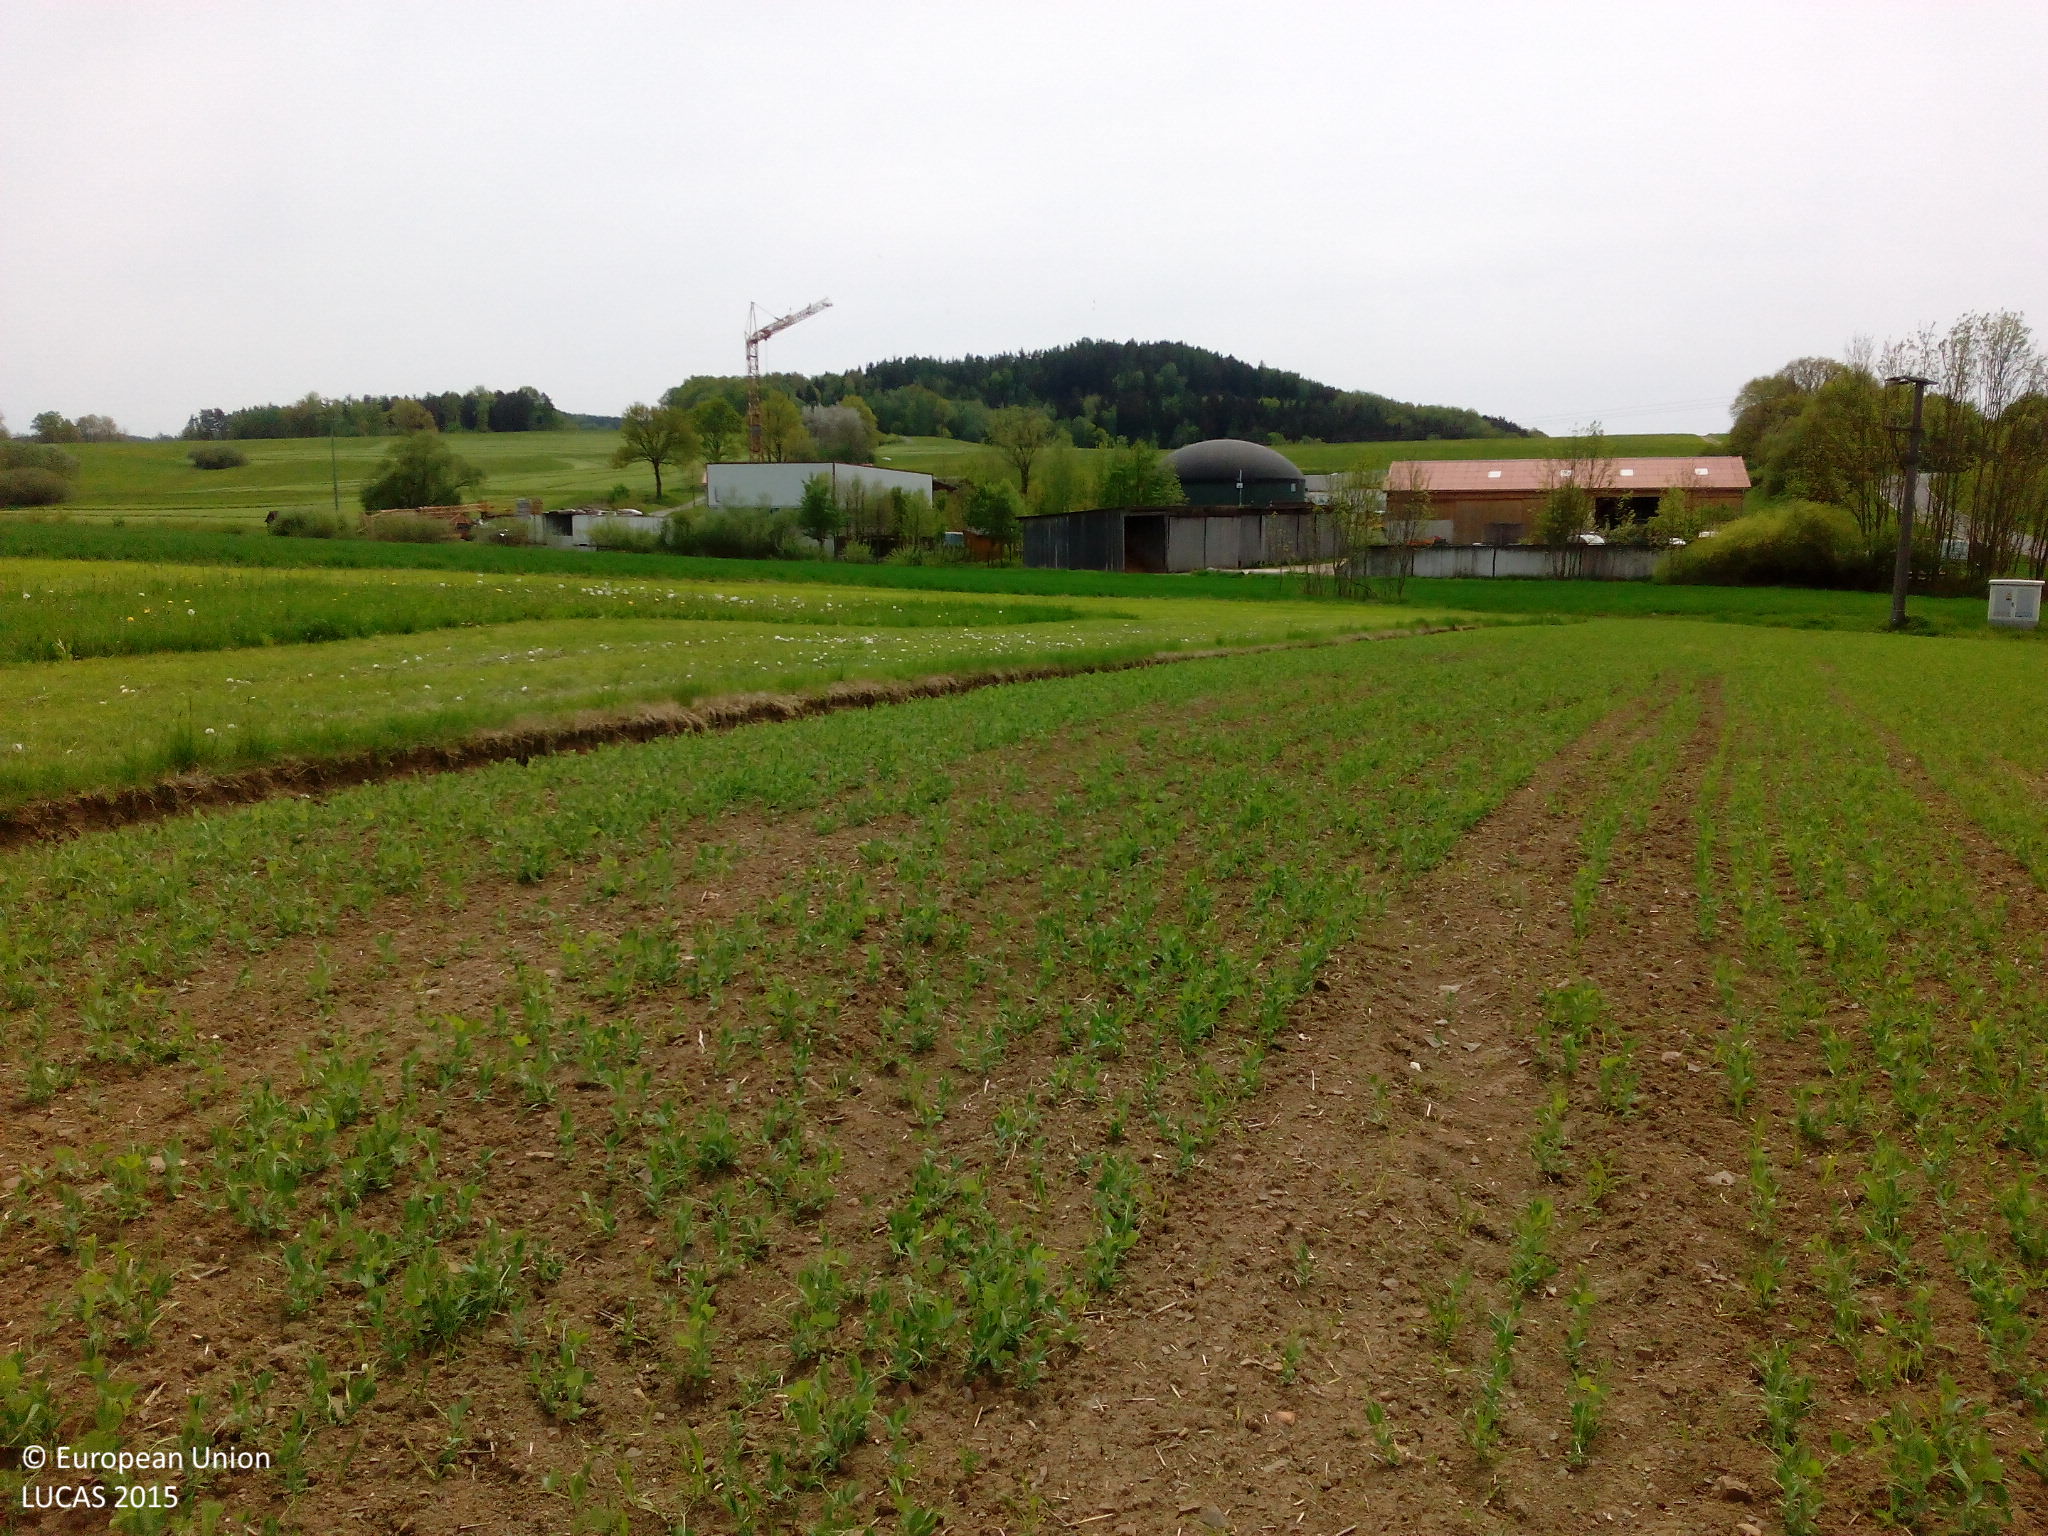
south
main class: Cropland
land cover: Dry pulses
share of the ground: 25 - 50 %
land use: Agriculture (excluding fallow land and kitchen gardens)
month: May
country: DE
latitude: 49.9051
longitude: 11.4616
